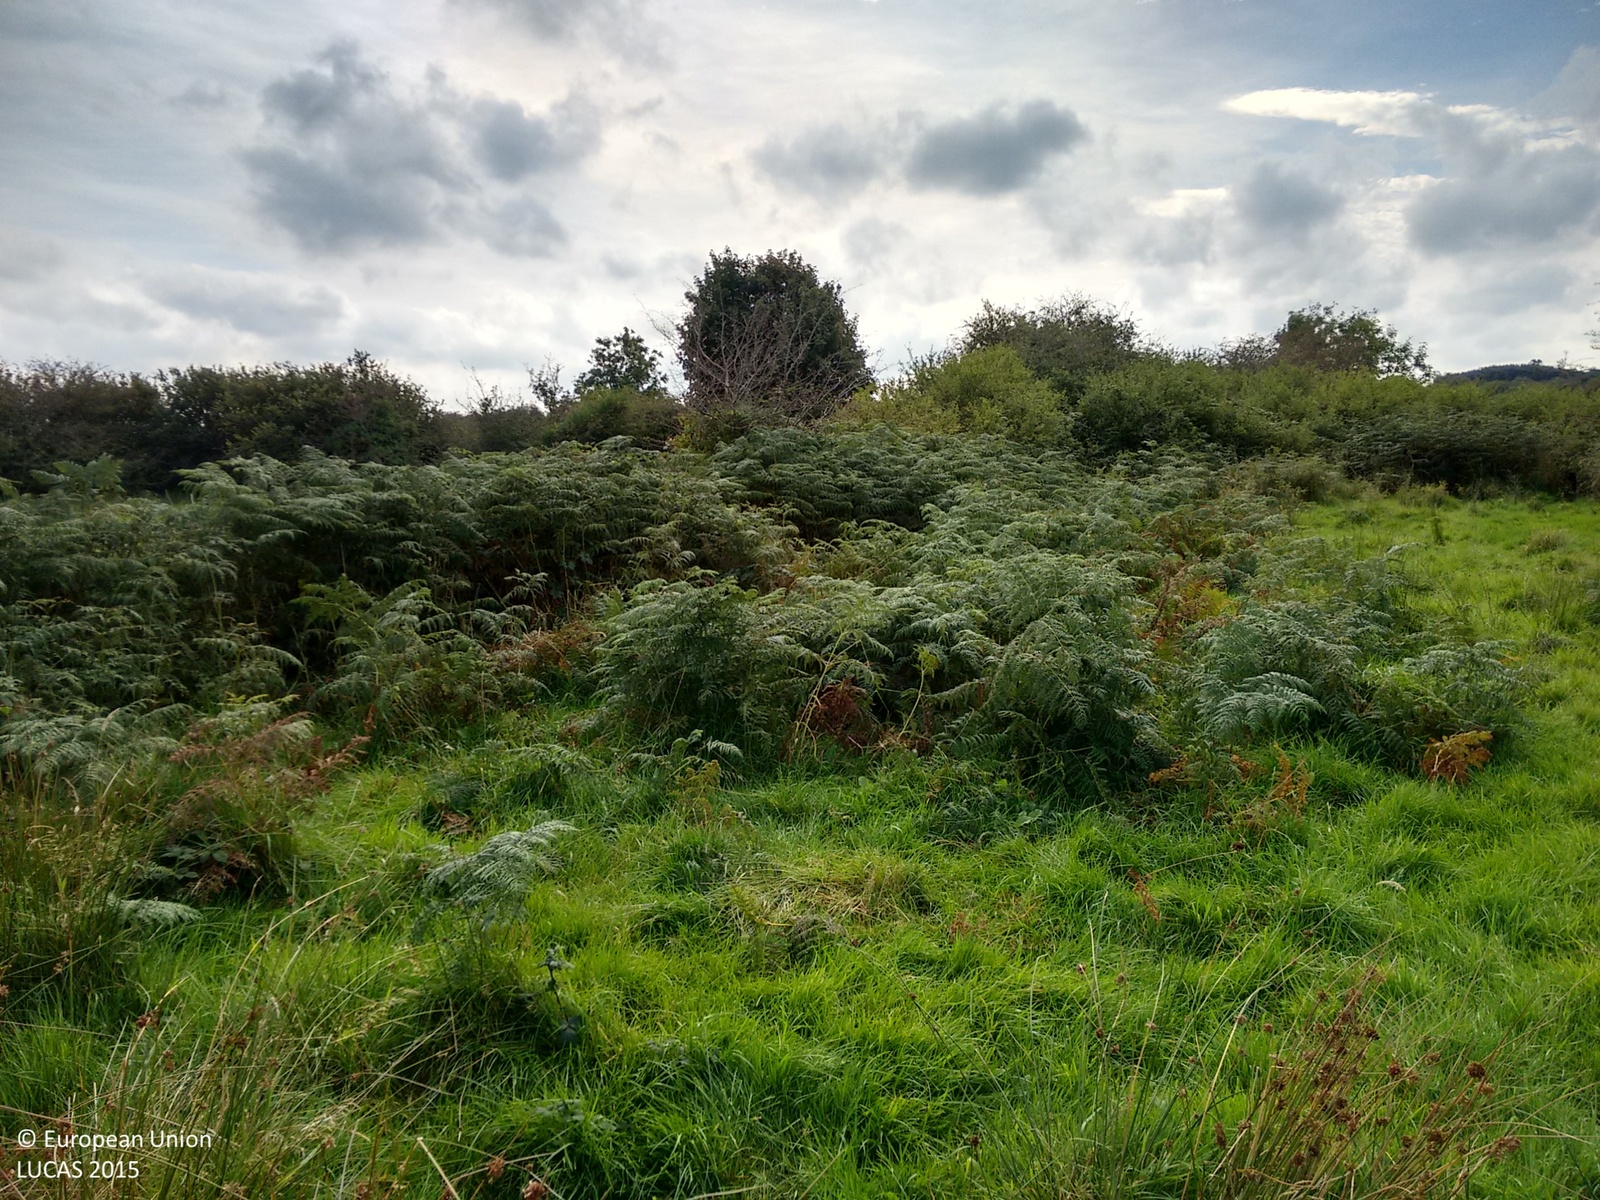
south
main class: Grassland
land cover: Grassland without tree/shrub cover
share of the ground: > 75 %
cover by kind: herbaceous plants 100 %
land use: Agriculture (excluding fallow land and kitchen gardens)
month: September
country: IE
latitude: 53.8811
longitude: -8.9672
